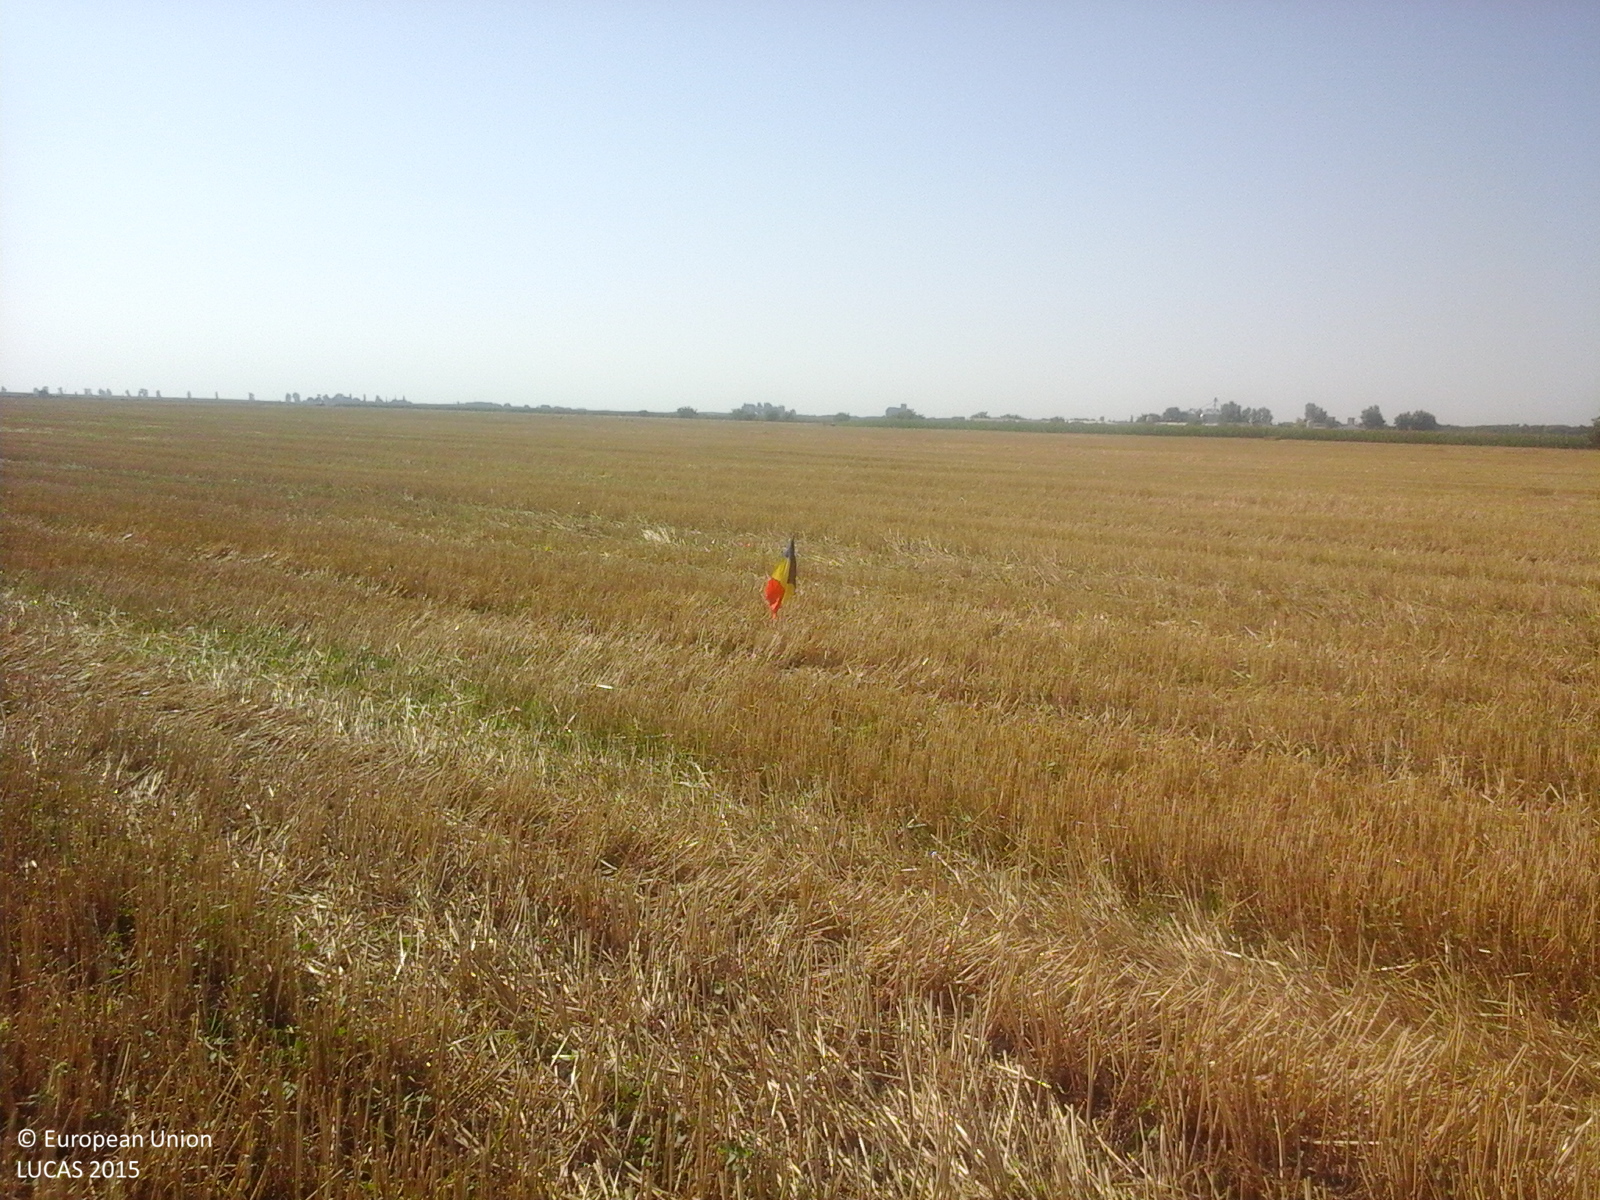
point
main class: Cropland
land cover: Durum wheat
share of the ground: > 75 %
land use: Agriculture (excluding fallow land and kitchen gardens)
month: July
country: RO
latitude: 44.4540
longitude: 27.1612
